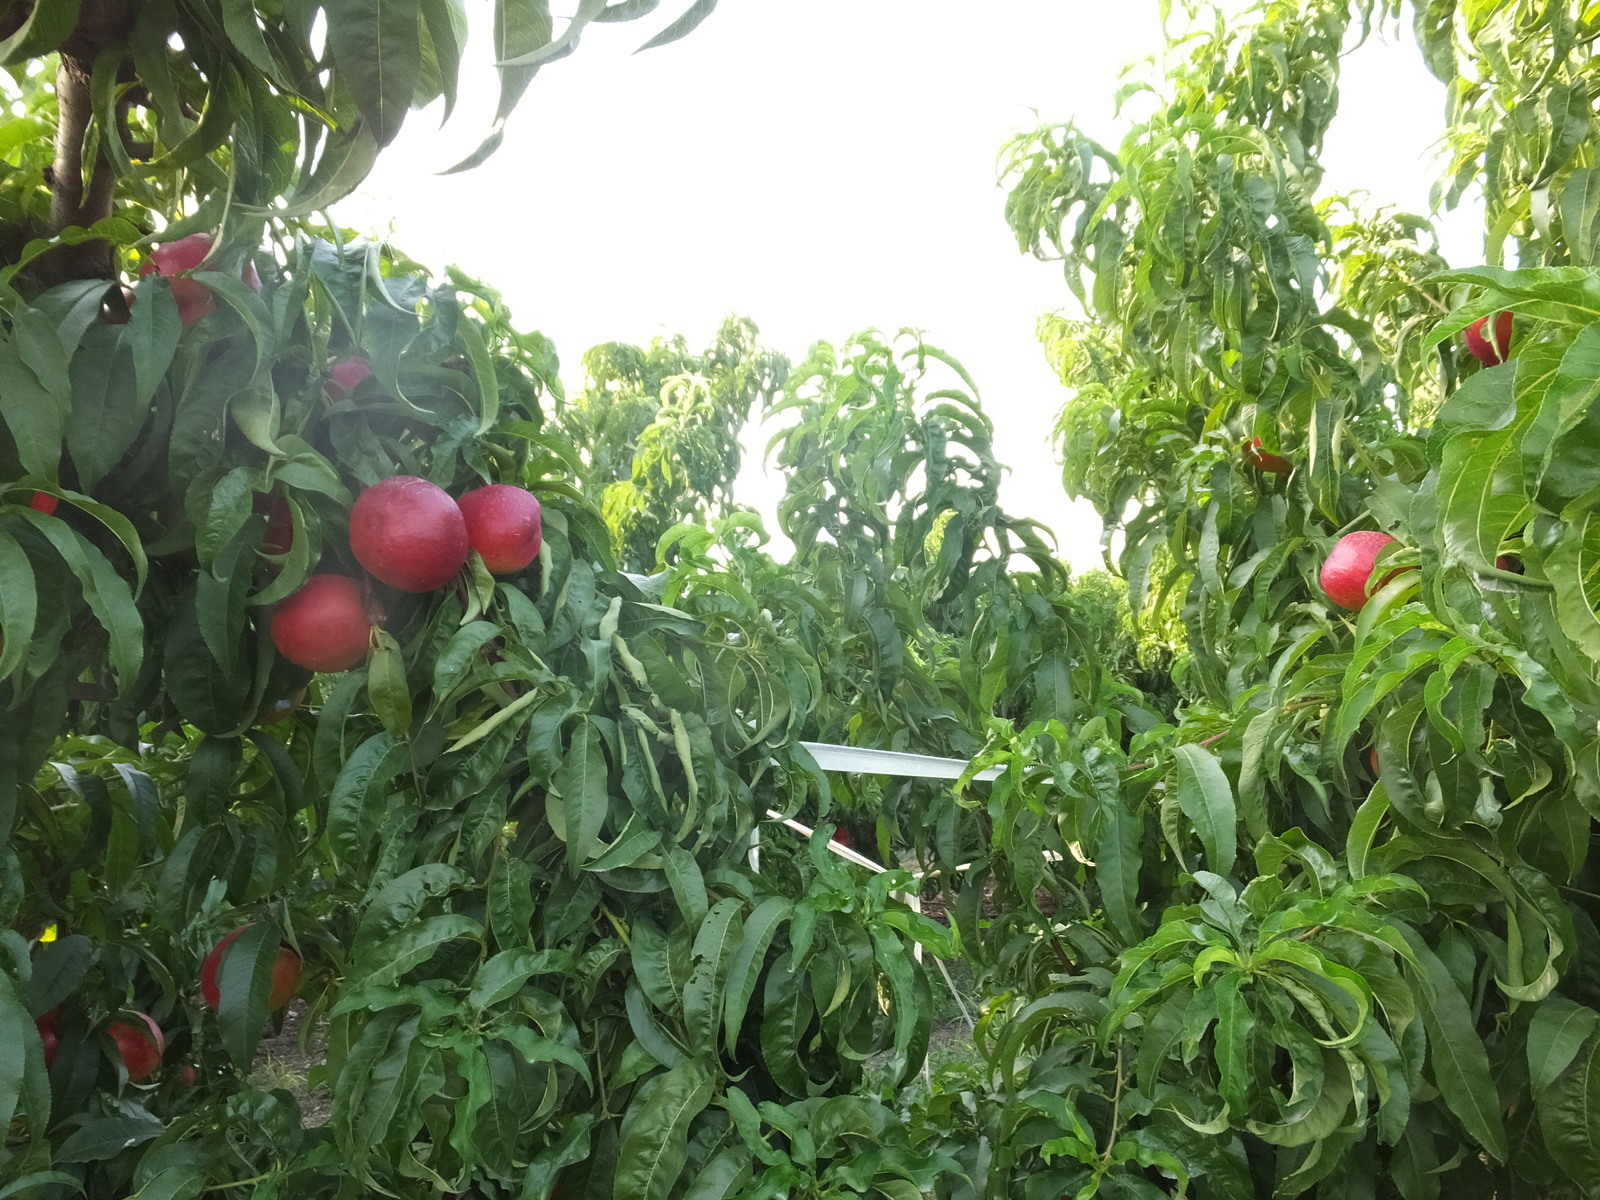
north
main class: Cropland
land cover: Other fruit trees and berries
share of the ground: > 75 %
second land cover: Spontaneously vegetated surfaces
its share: 10 - 25 %
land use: Agriculture (excluding fallow land and kitchen gardens)
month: August
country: ES
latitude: 41.5995
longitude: 0.4246
